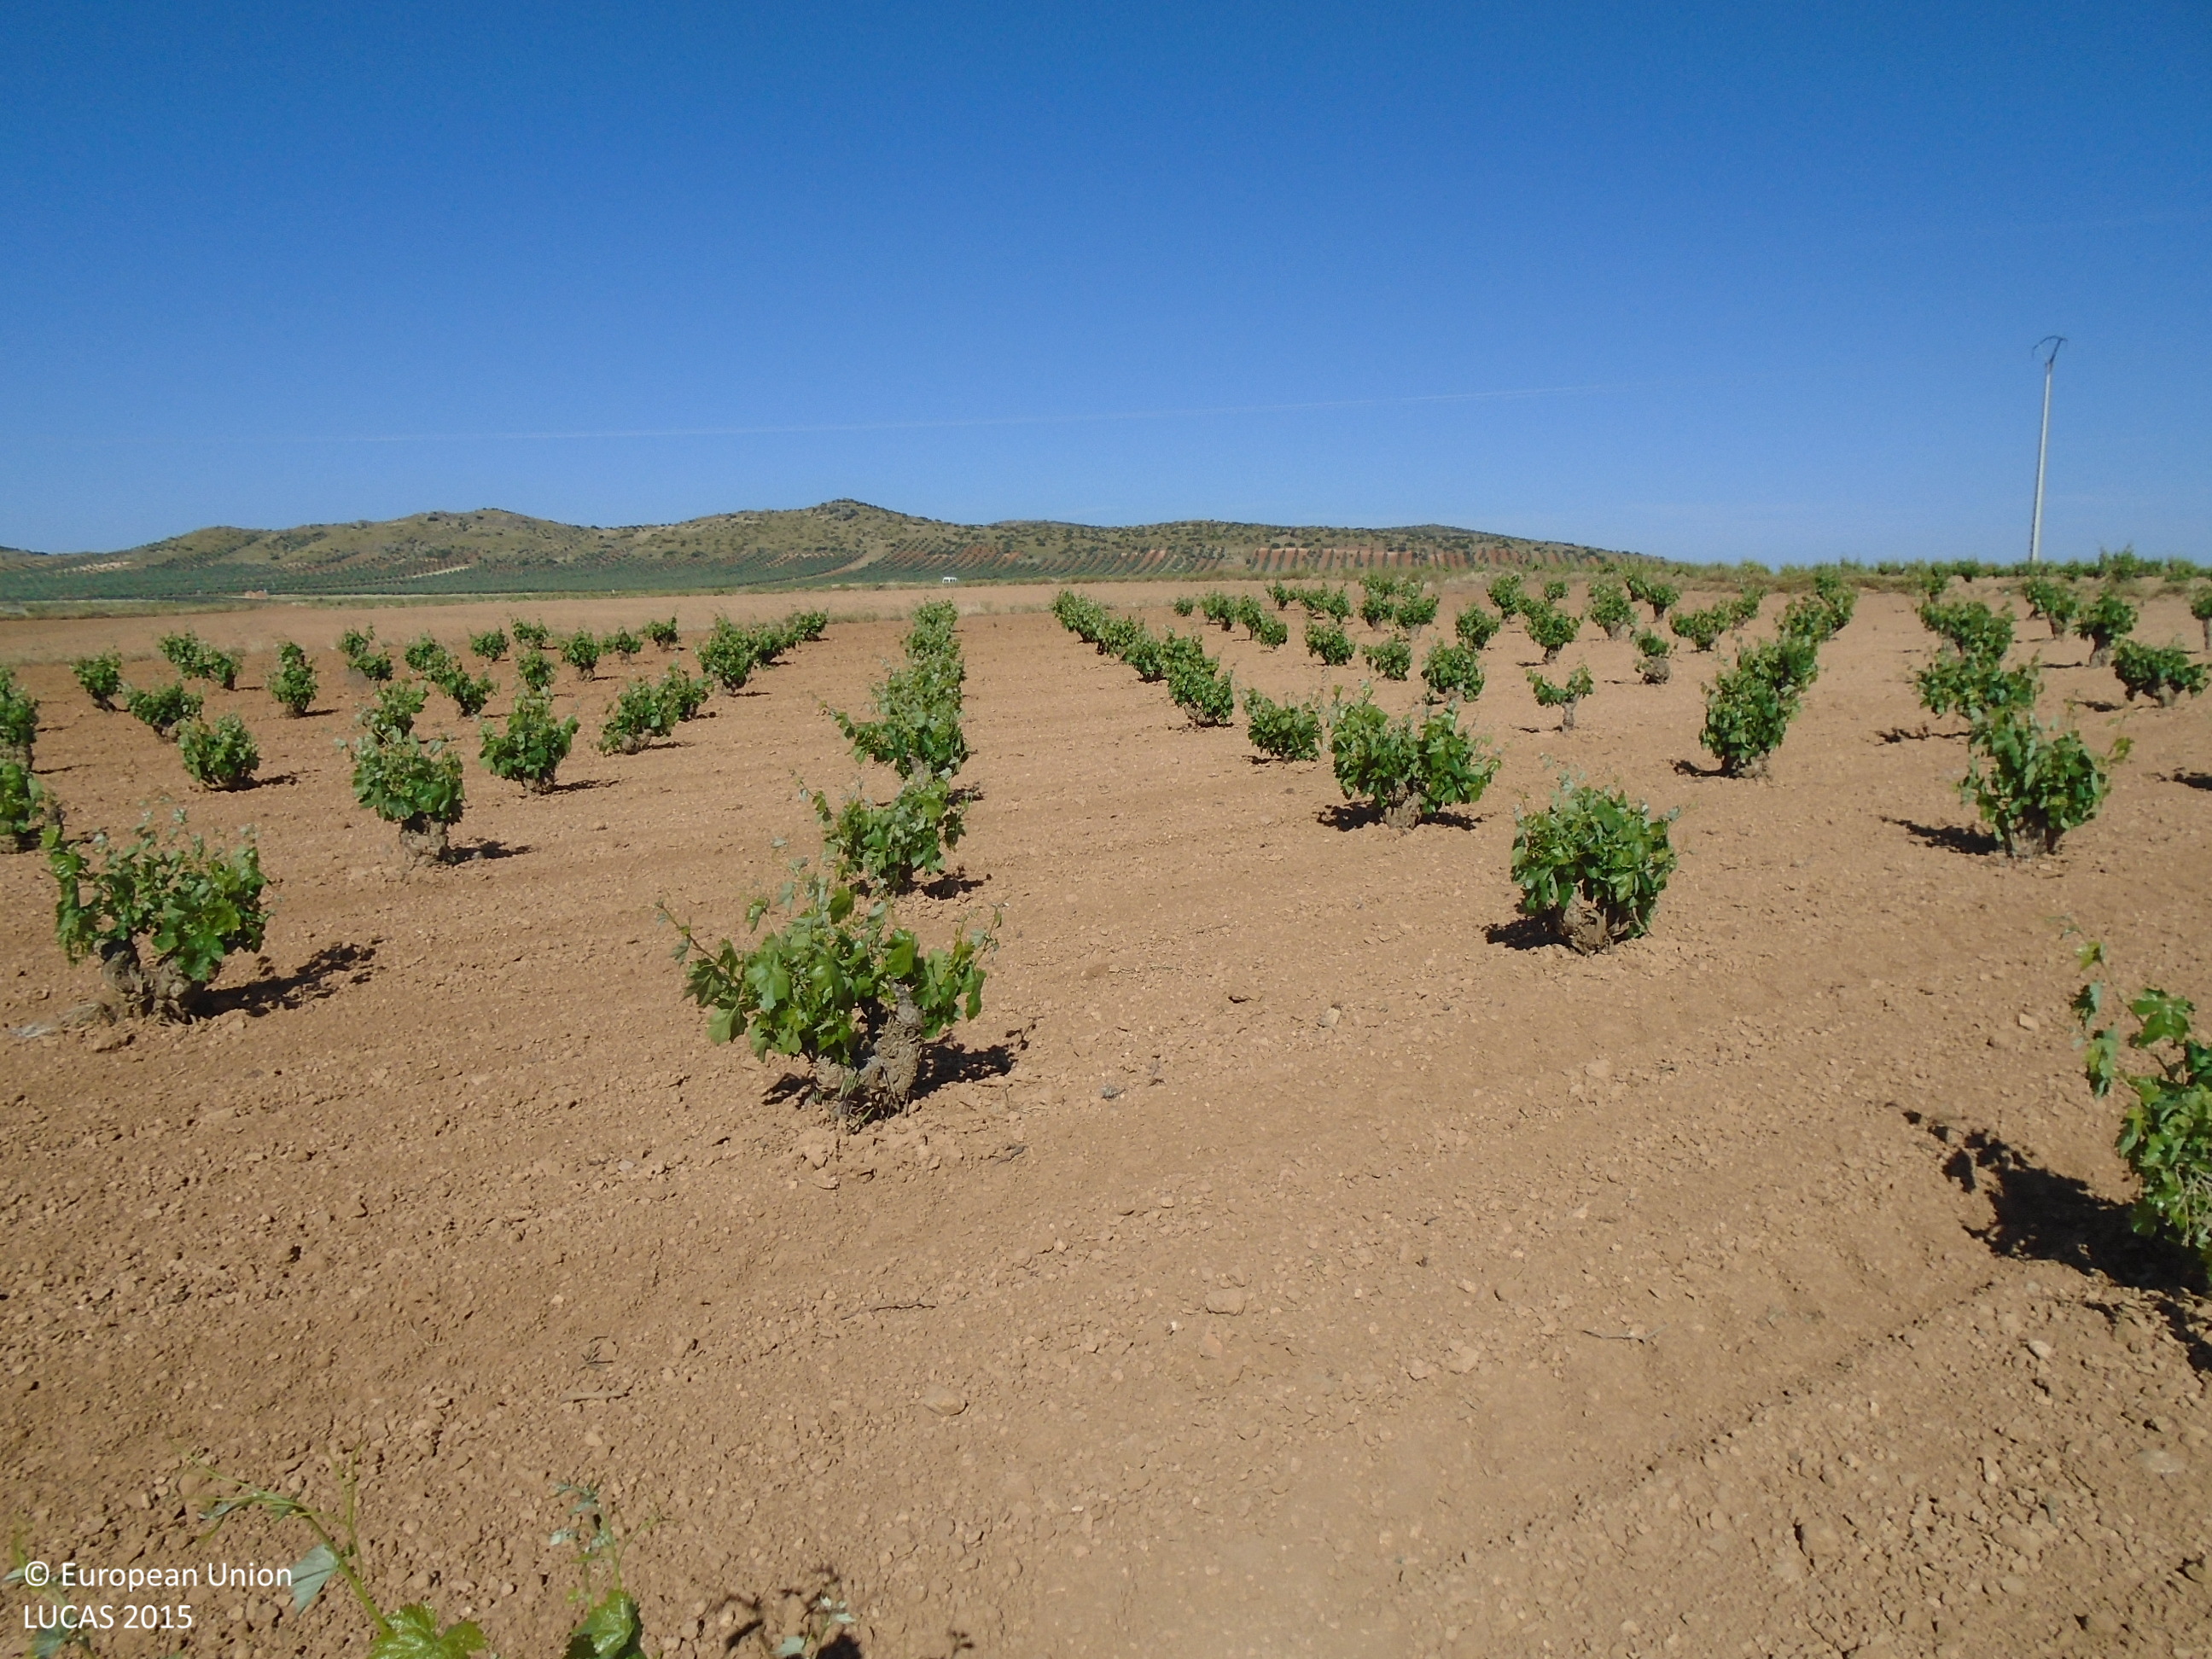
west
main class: Cropland
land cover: Vineyards
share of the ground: 10 - 25 %
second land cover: Other bare soil
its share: > 75 %
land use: Agriculture (excluding fallow land and kitchen gardens)
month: May
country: ES
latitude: 39.4752
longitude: -3.6366
